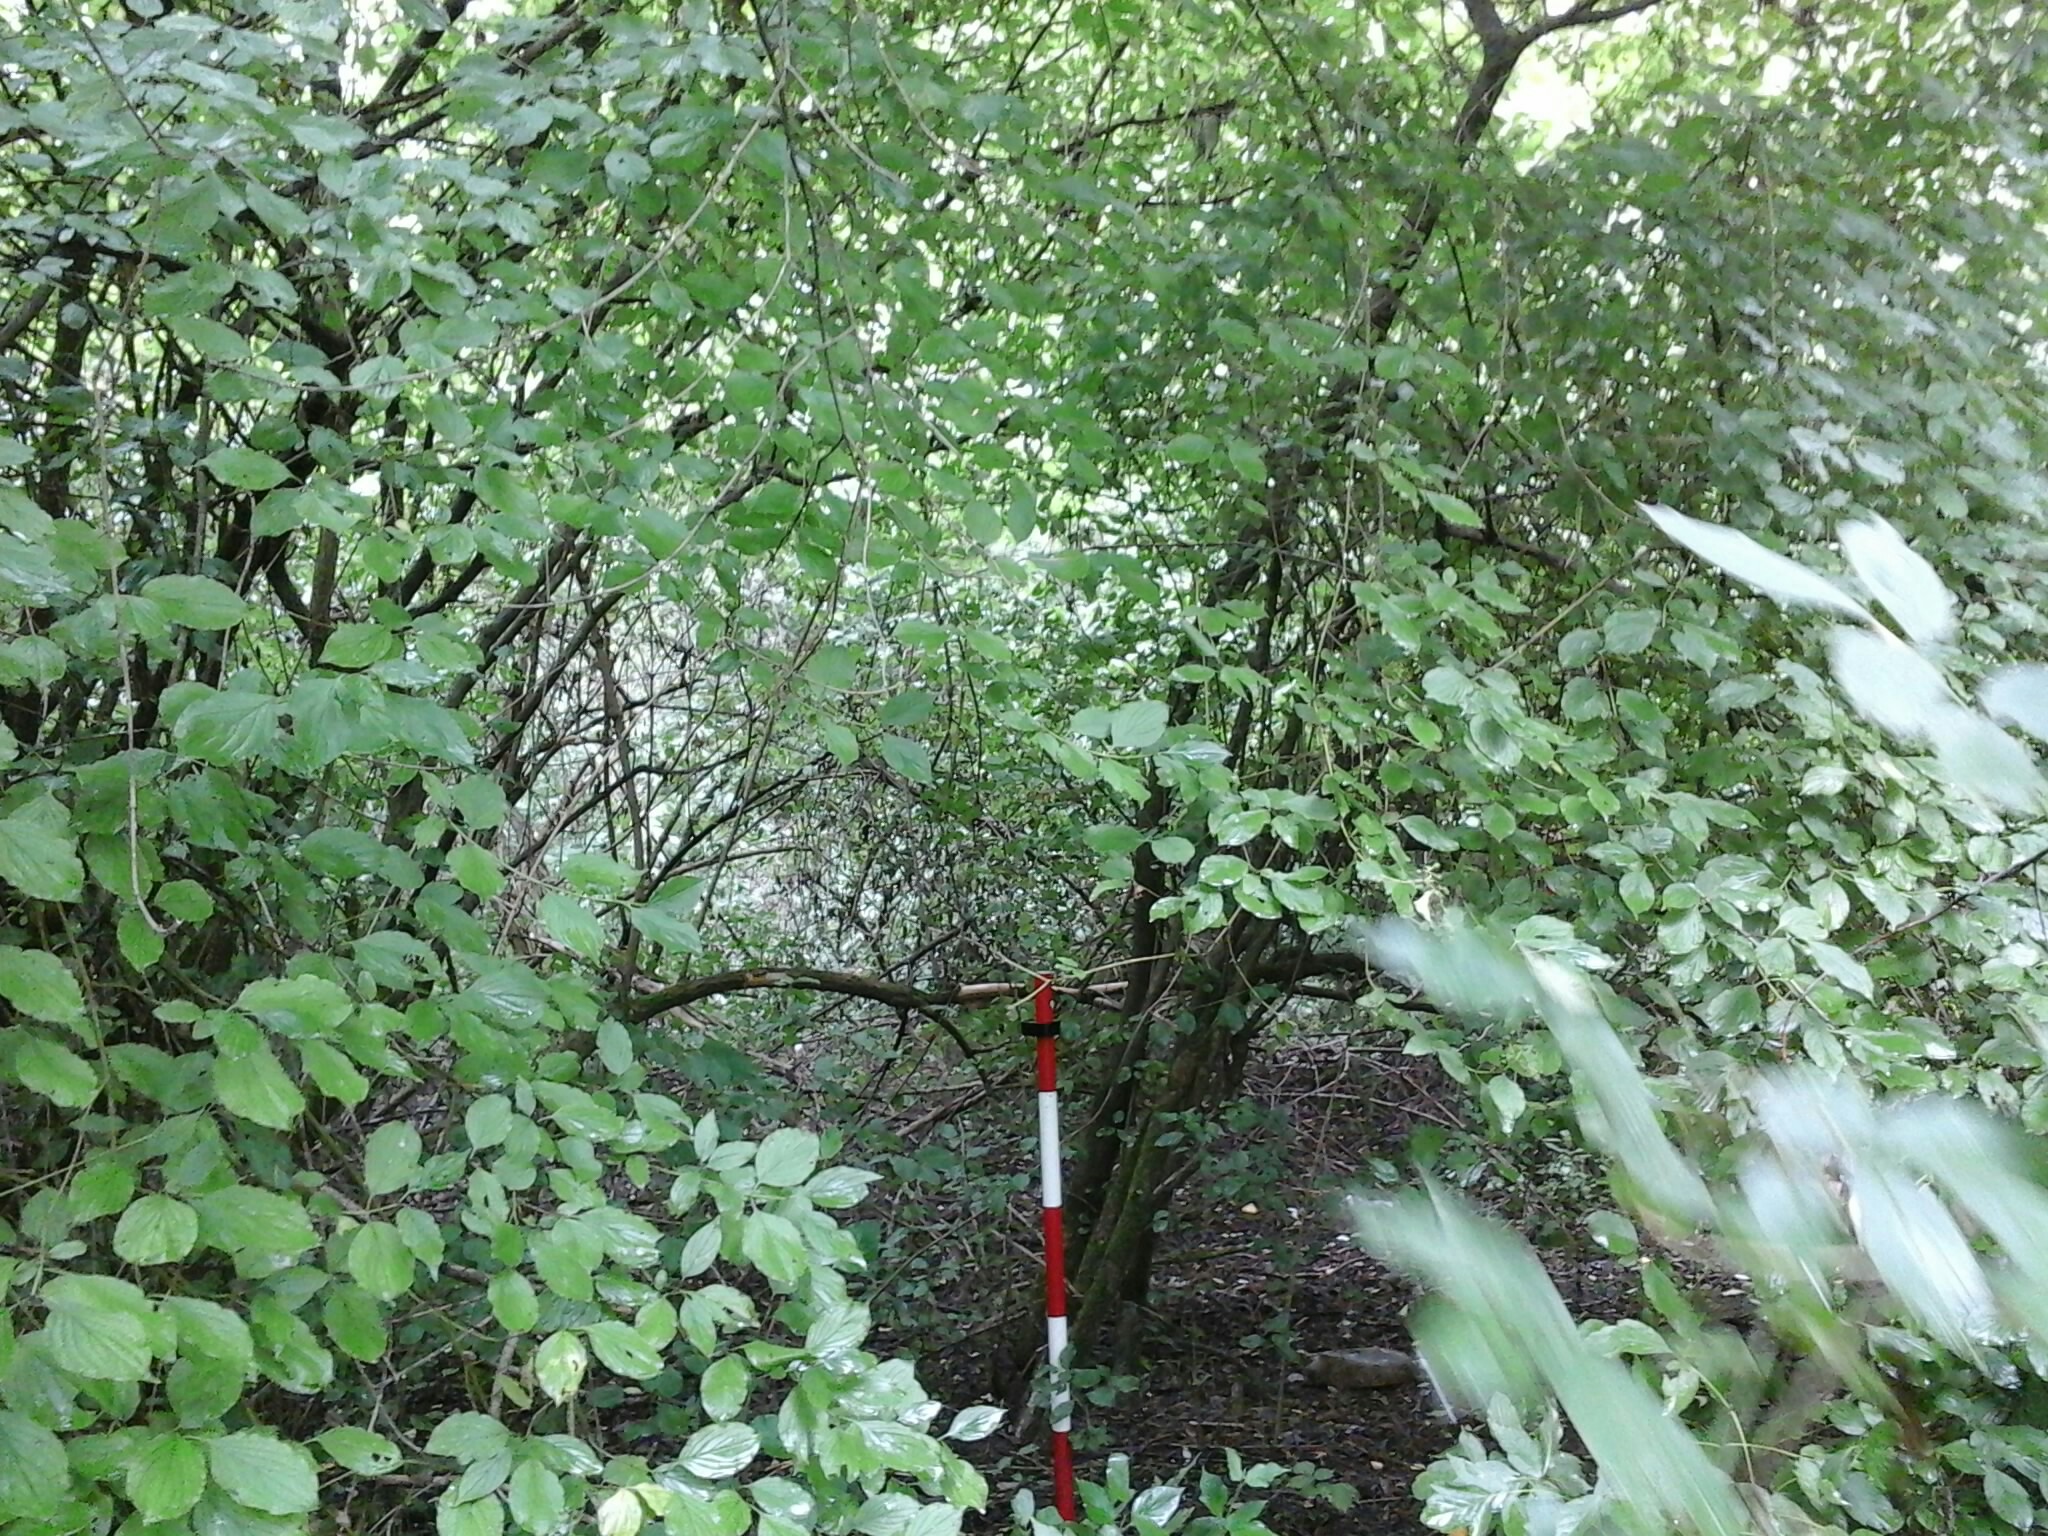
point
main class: Woodland
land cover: Broadleaved woodland
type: floodplain forest
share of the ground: > 75 %
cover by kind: broadleaved forest trees 95 %, herbaceous plants 5 %
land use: Forestry
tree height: > 5 m
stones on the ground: < 10 %
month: July
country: HU
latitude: 48.3362
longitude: 22.2662
